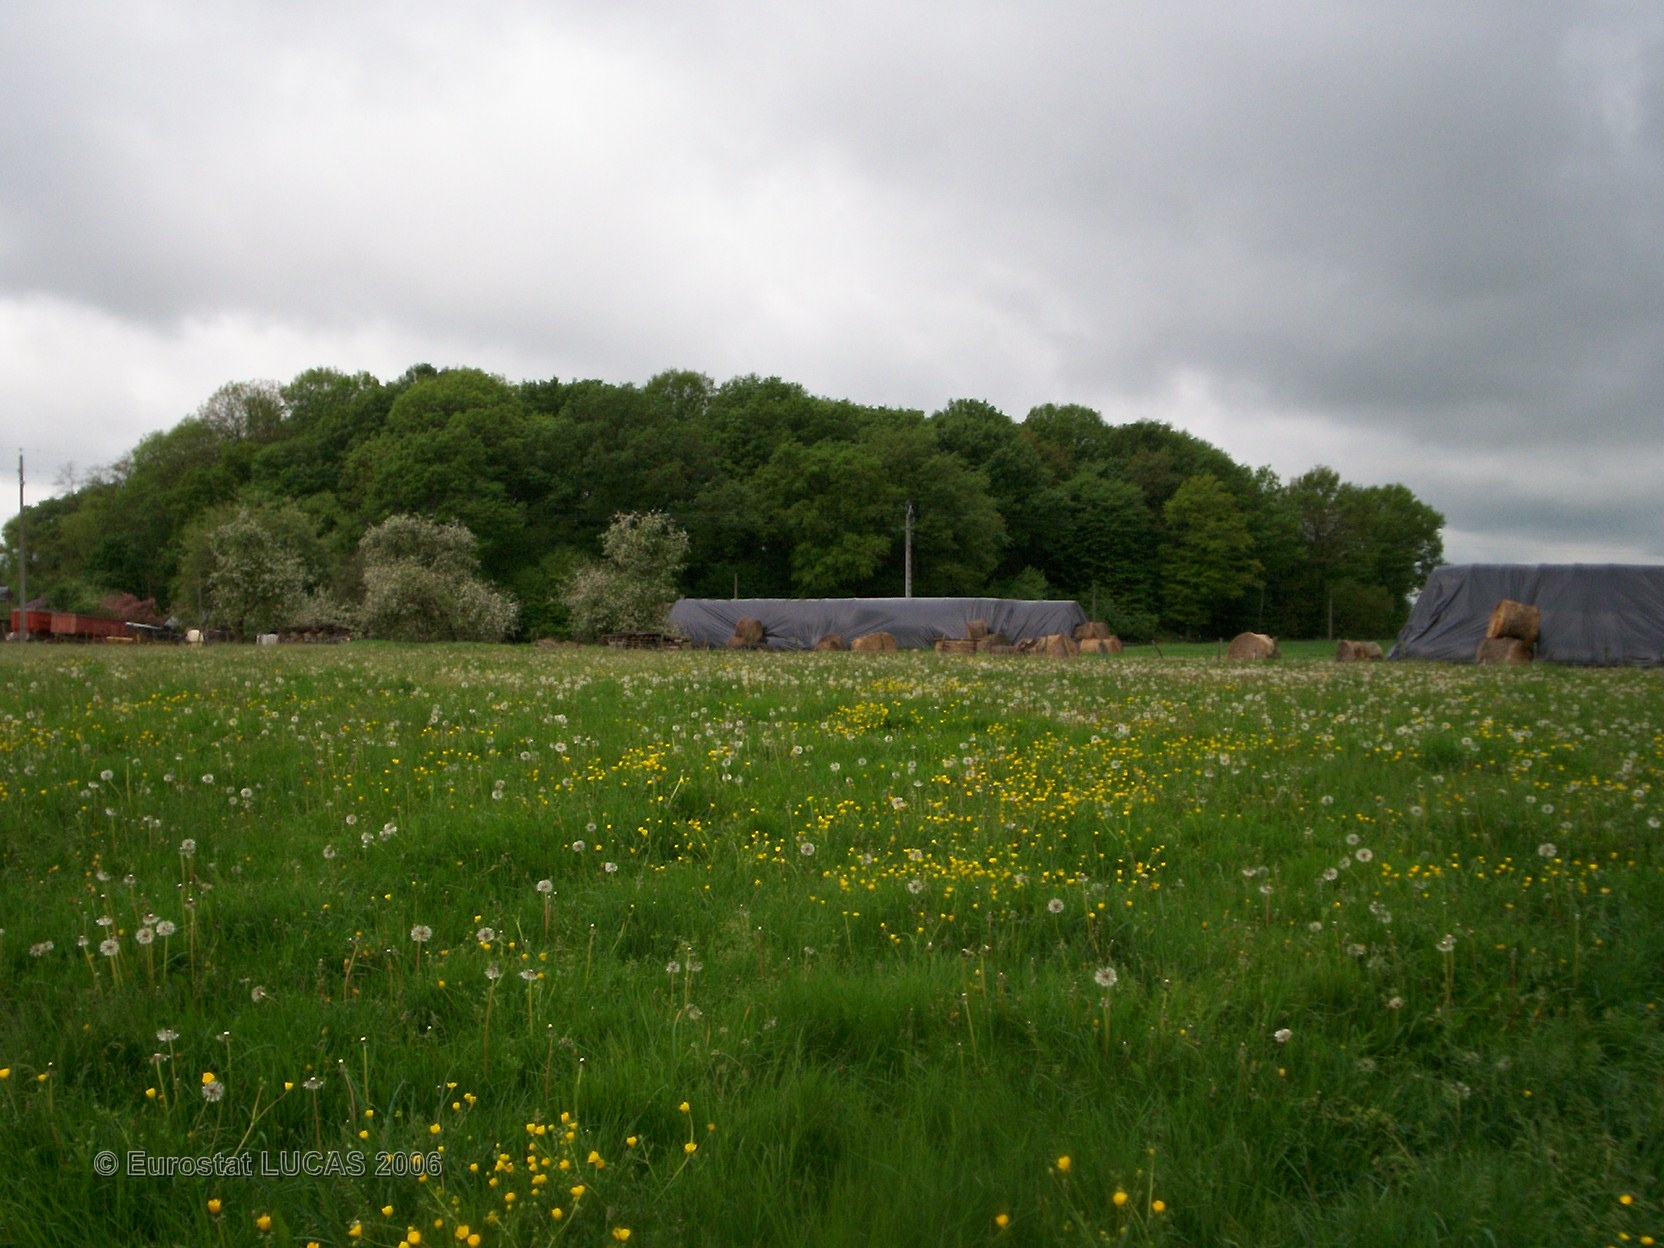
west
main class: Grassland
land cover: Grassland without tree/shrub cover
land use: Agriculture (excluding fallow land and kitchen gardens)
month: May
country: FR
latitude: 48.0144
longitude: 2.9275
